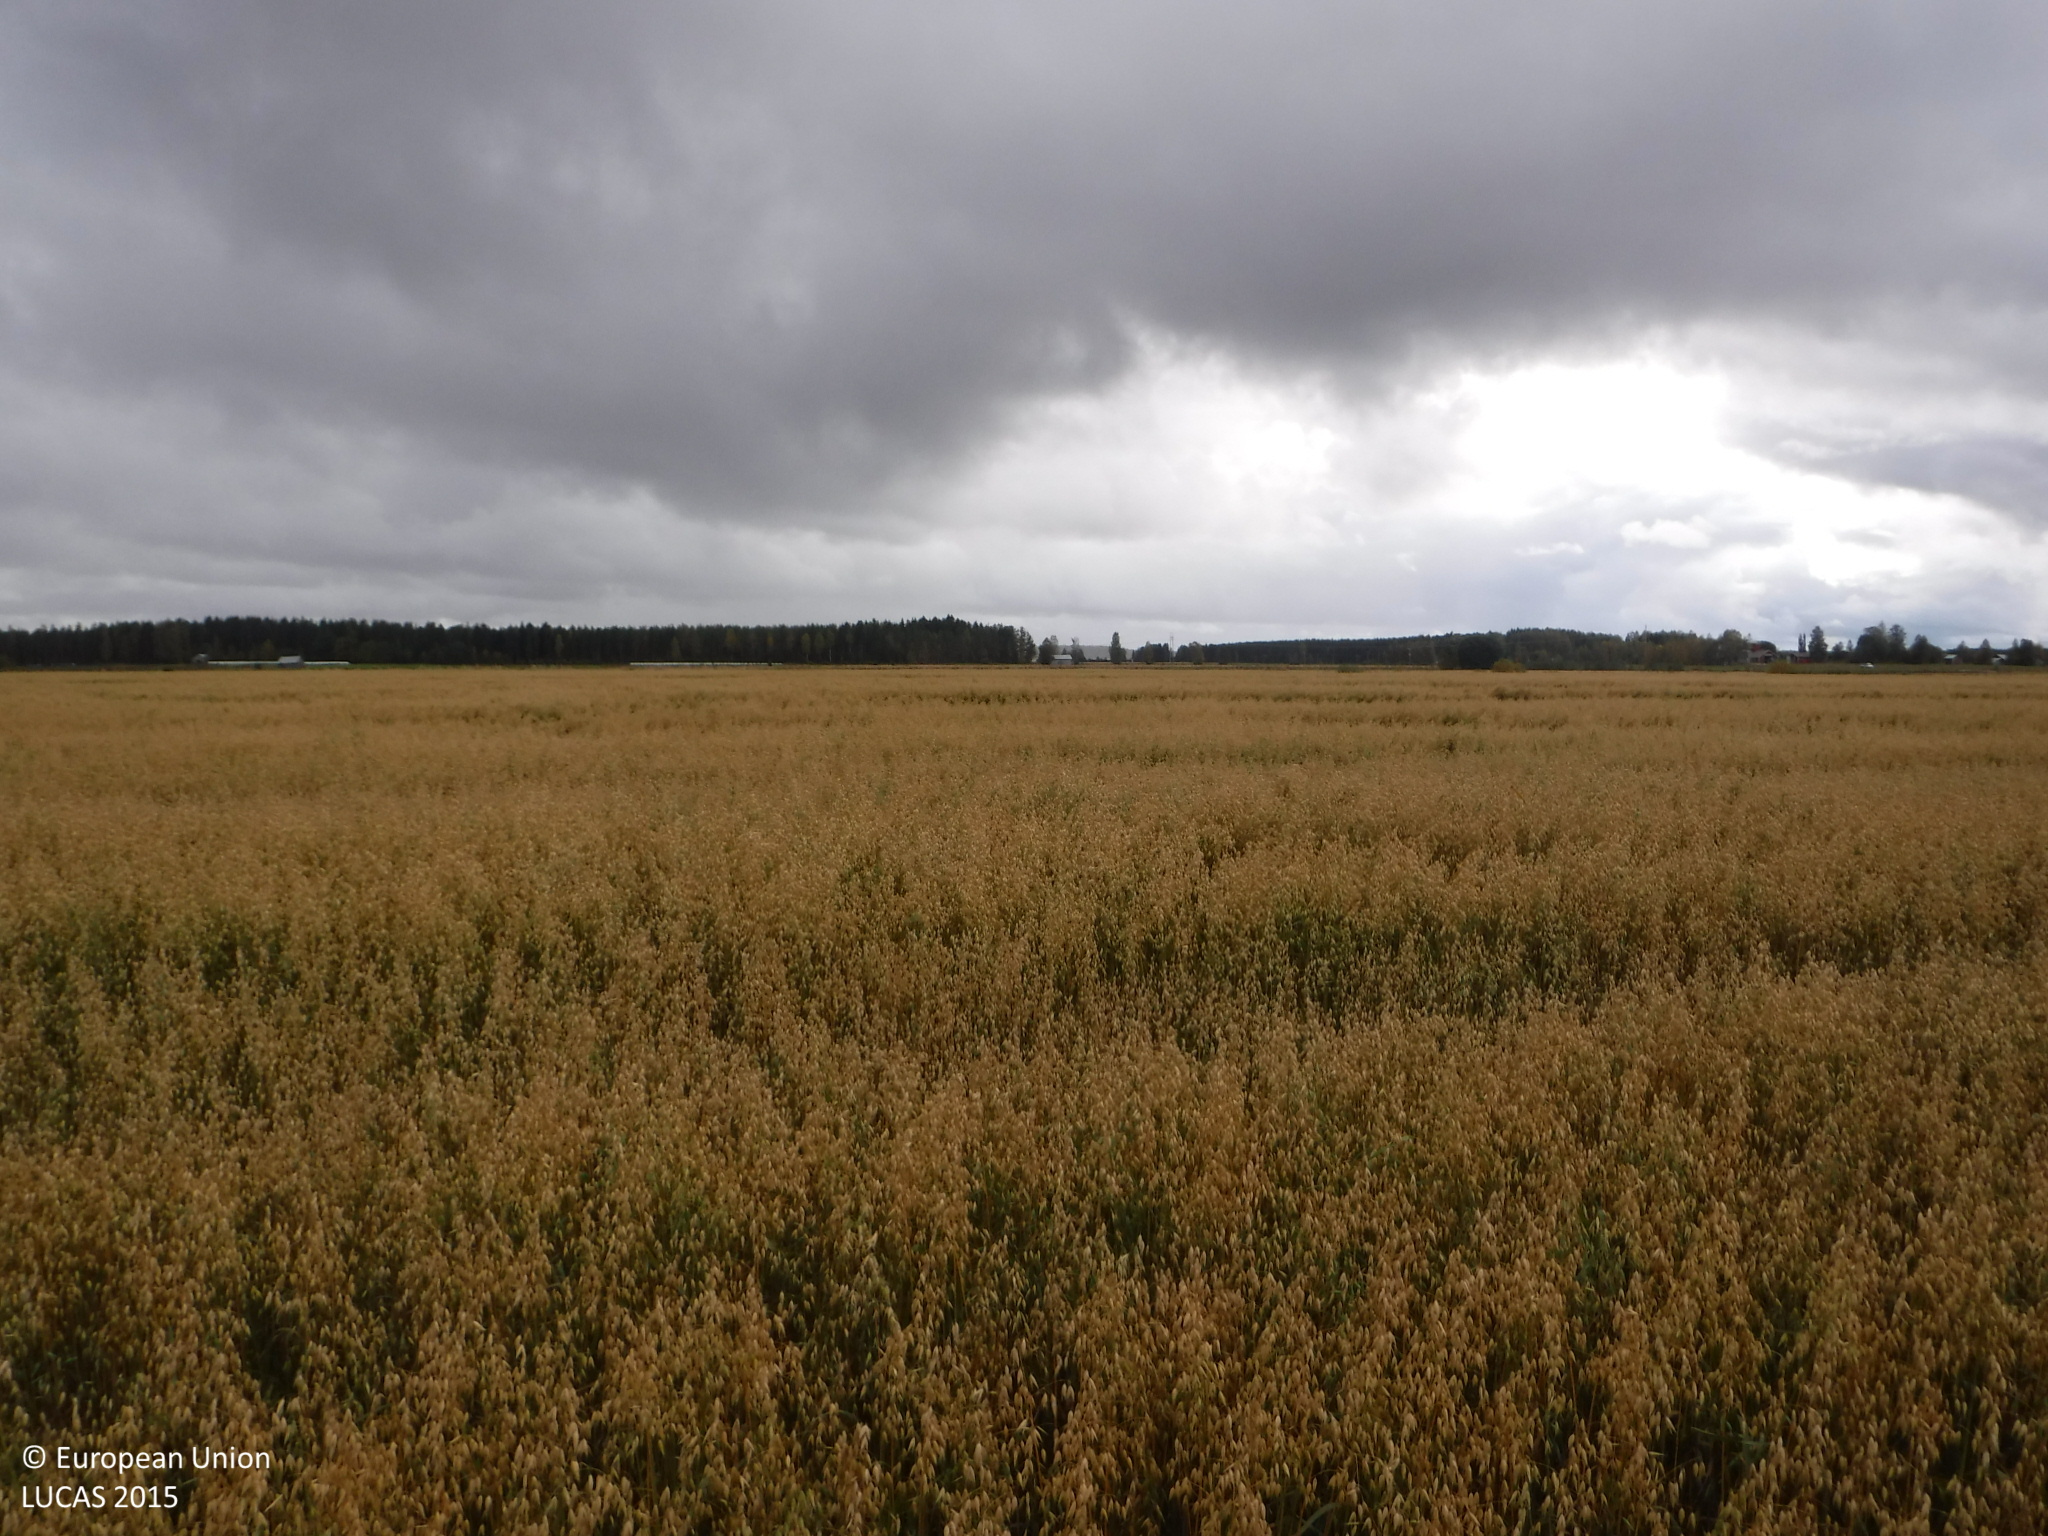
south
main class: Cropland
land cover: Oats
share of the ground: > 75 %
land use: Agriculture (excluding fallow land and kitchen gardens)
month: September
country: FI
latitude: 62.0528
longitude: 22.2783
